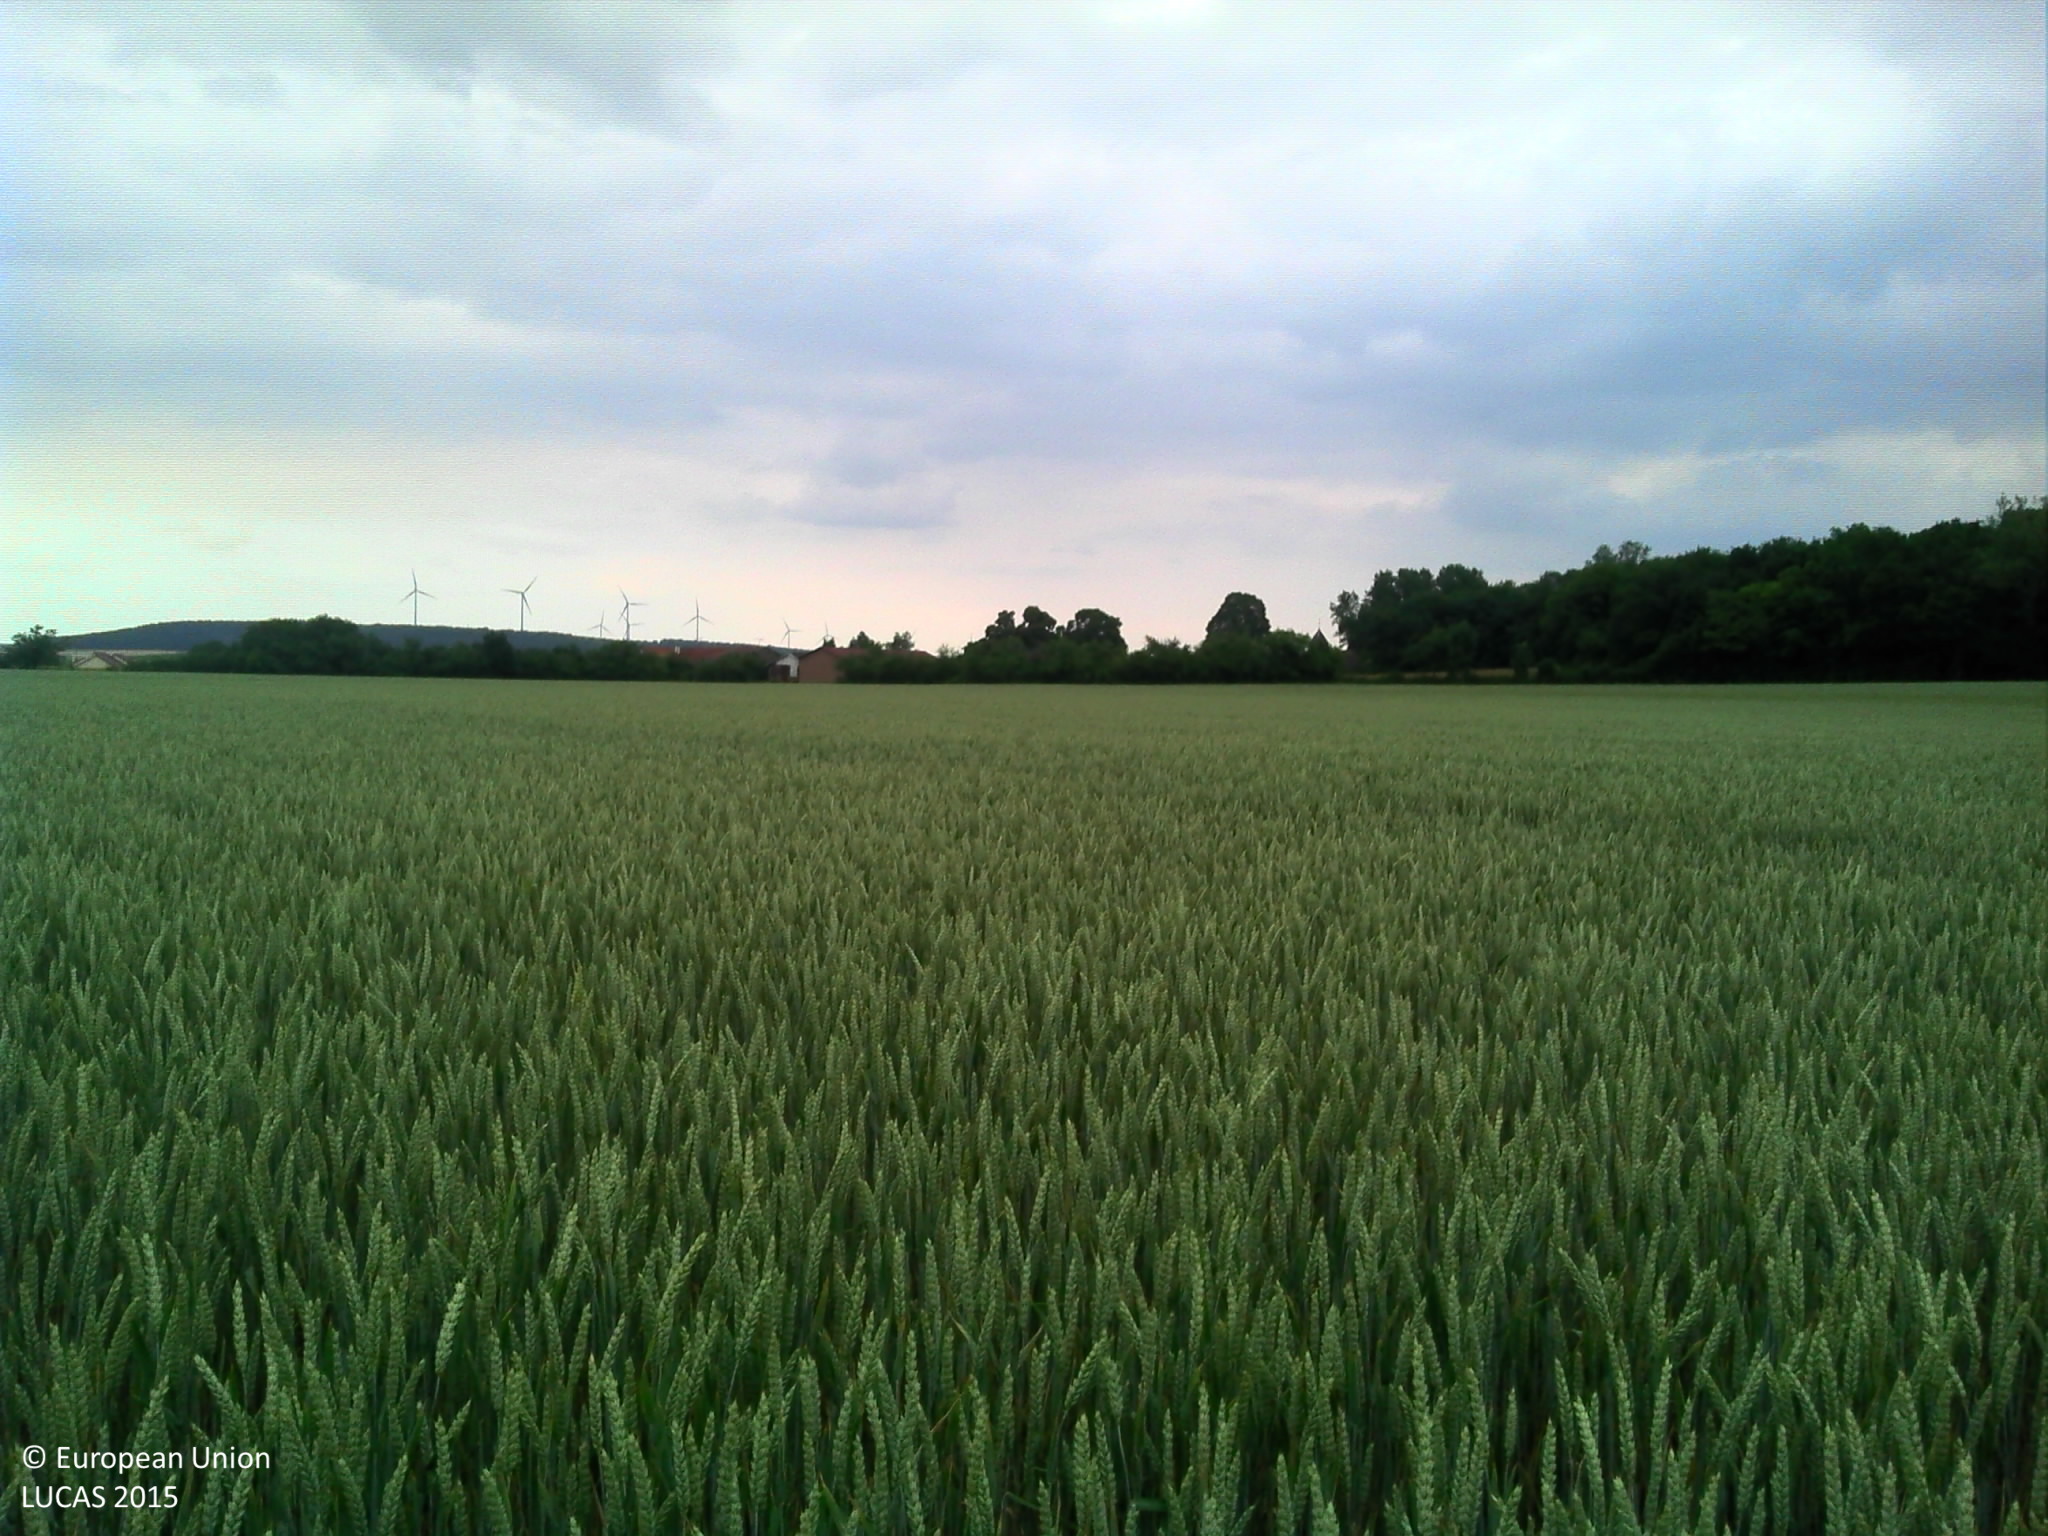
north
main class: Cropland
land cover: Common wheat
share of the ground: > 75 %
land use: Agriculture (excluding fallow land and kitchen gardens)
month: June
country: FR
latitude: 48.2748
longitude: 5.0538
